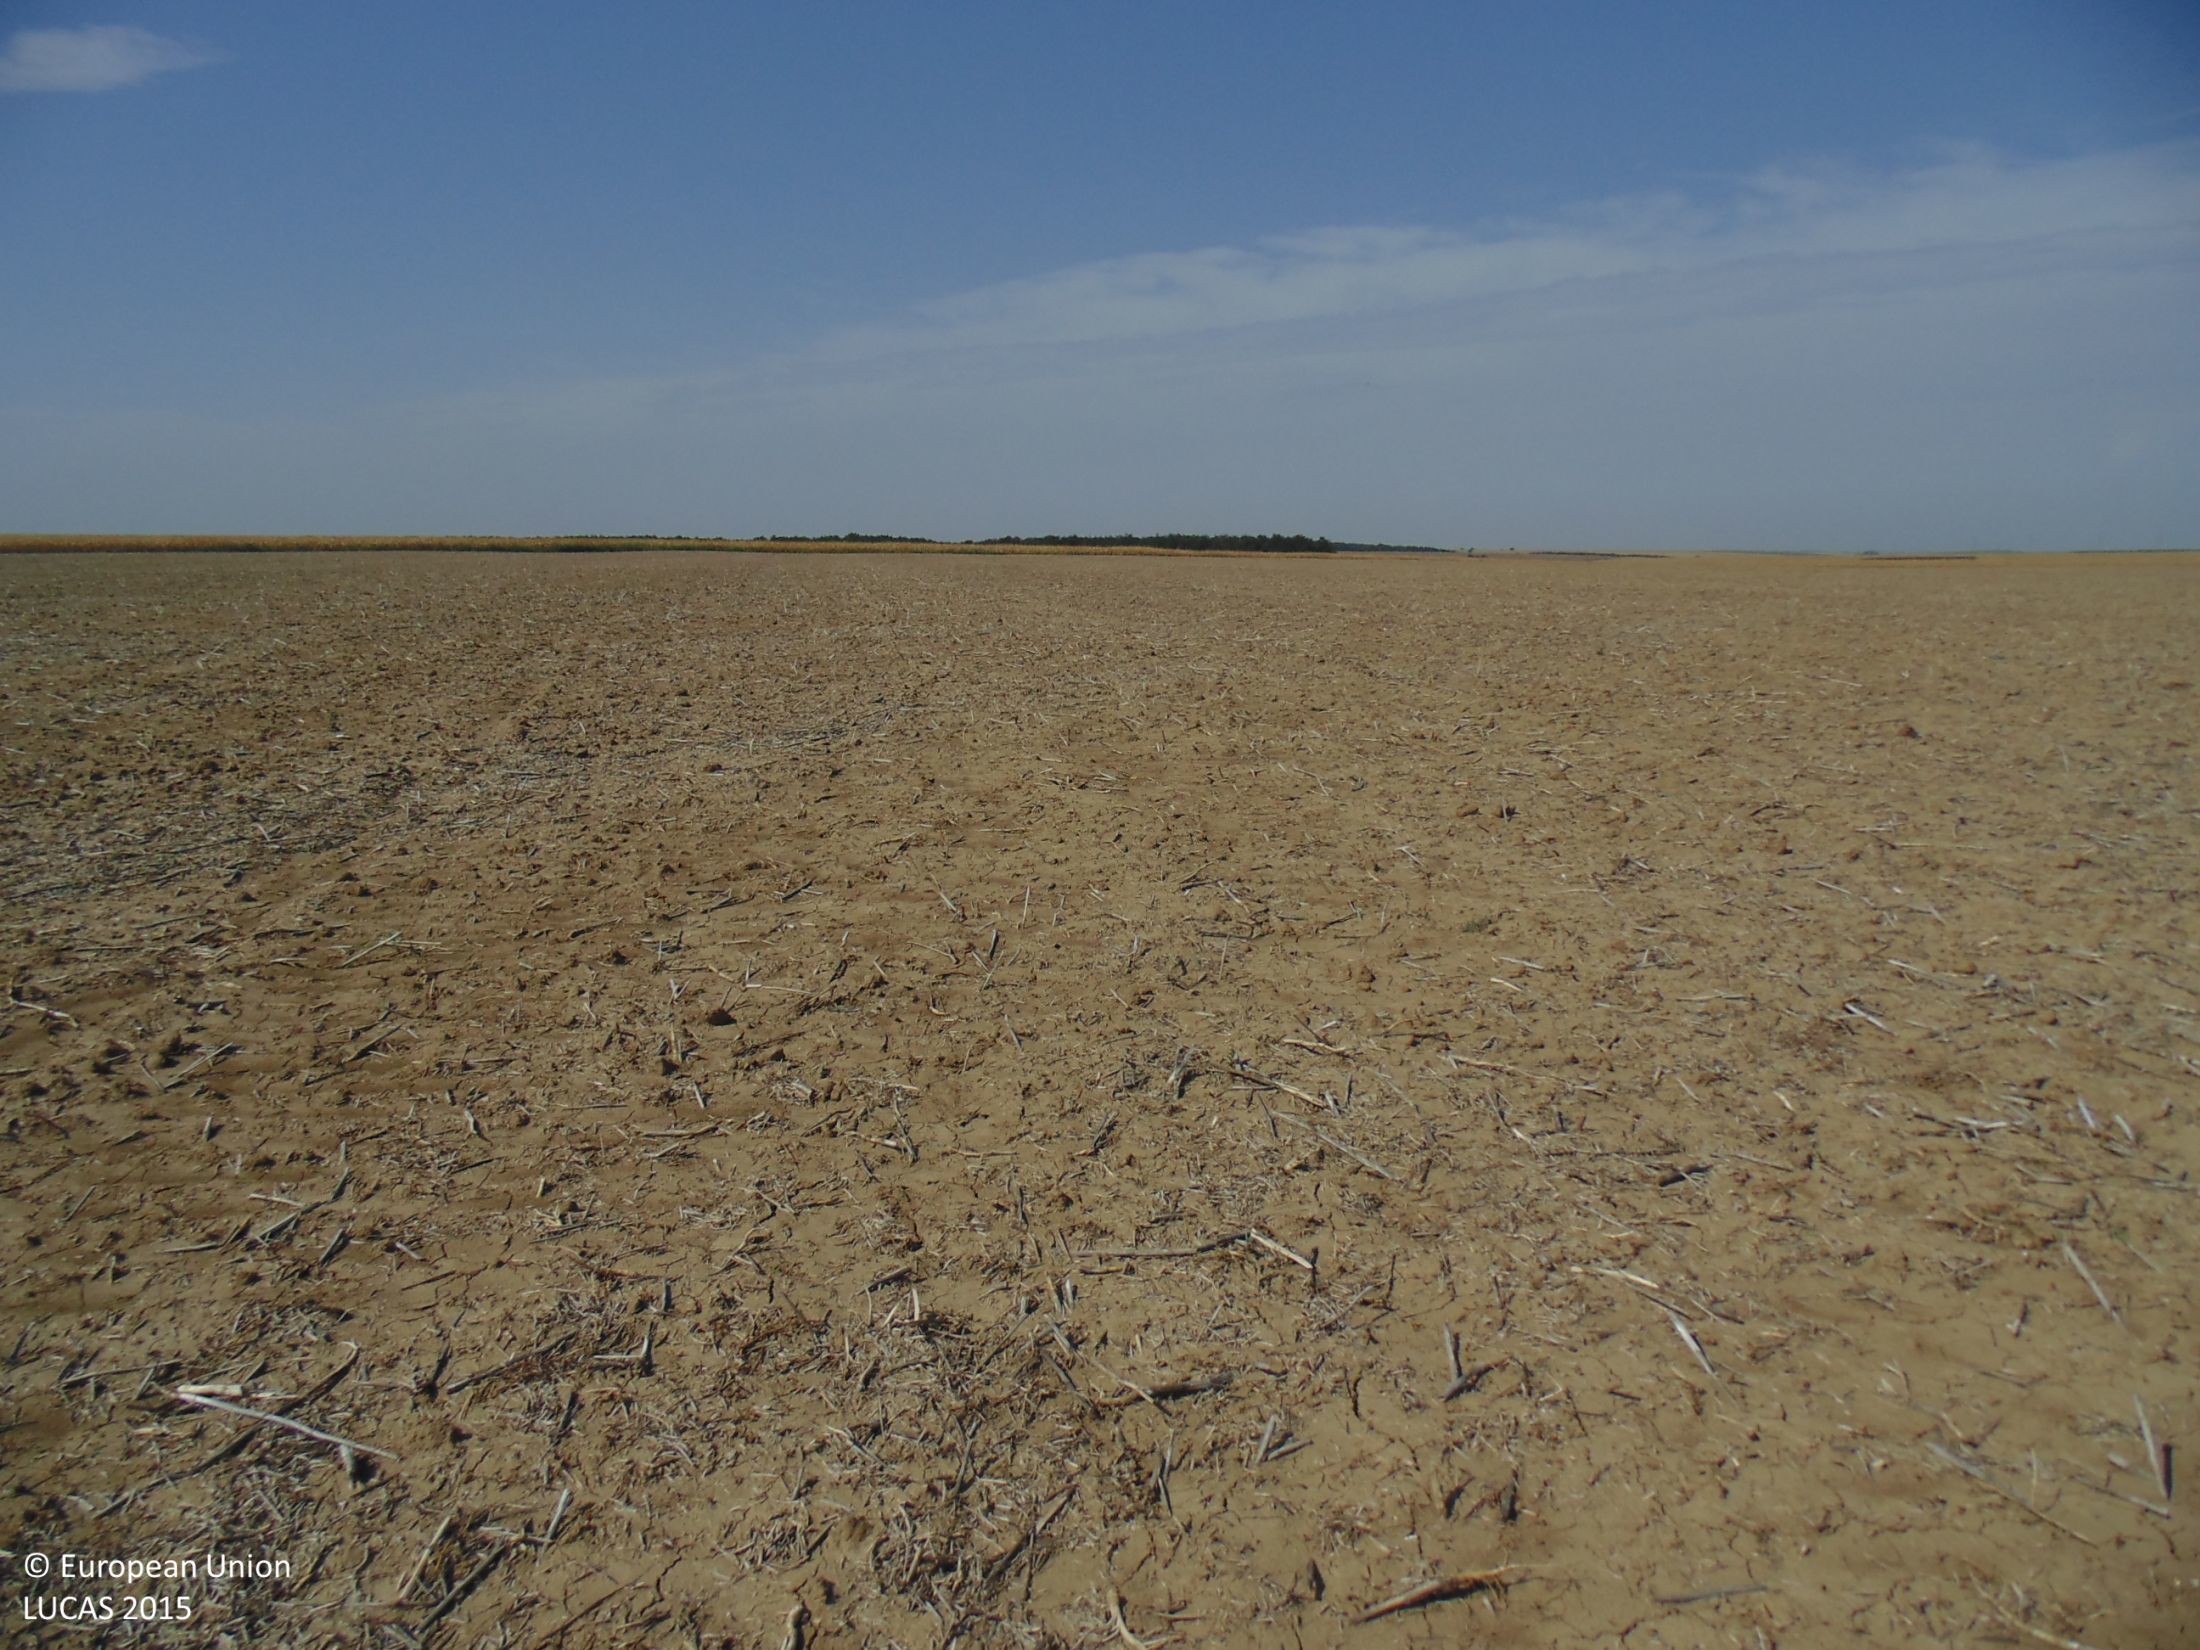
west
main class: Cropland
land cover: Rape and turnip rape
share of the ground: < 10 %
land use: Agriculture (excluding fallow land and kitchen gardens)
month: September
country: BG
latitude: 44.0793
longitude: 27.2001
